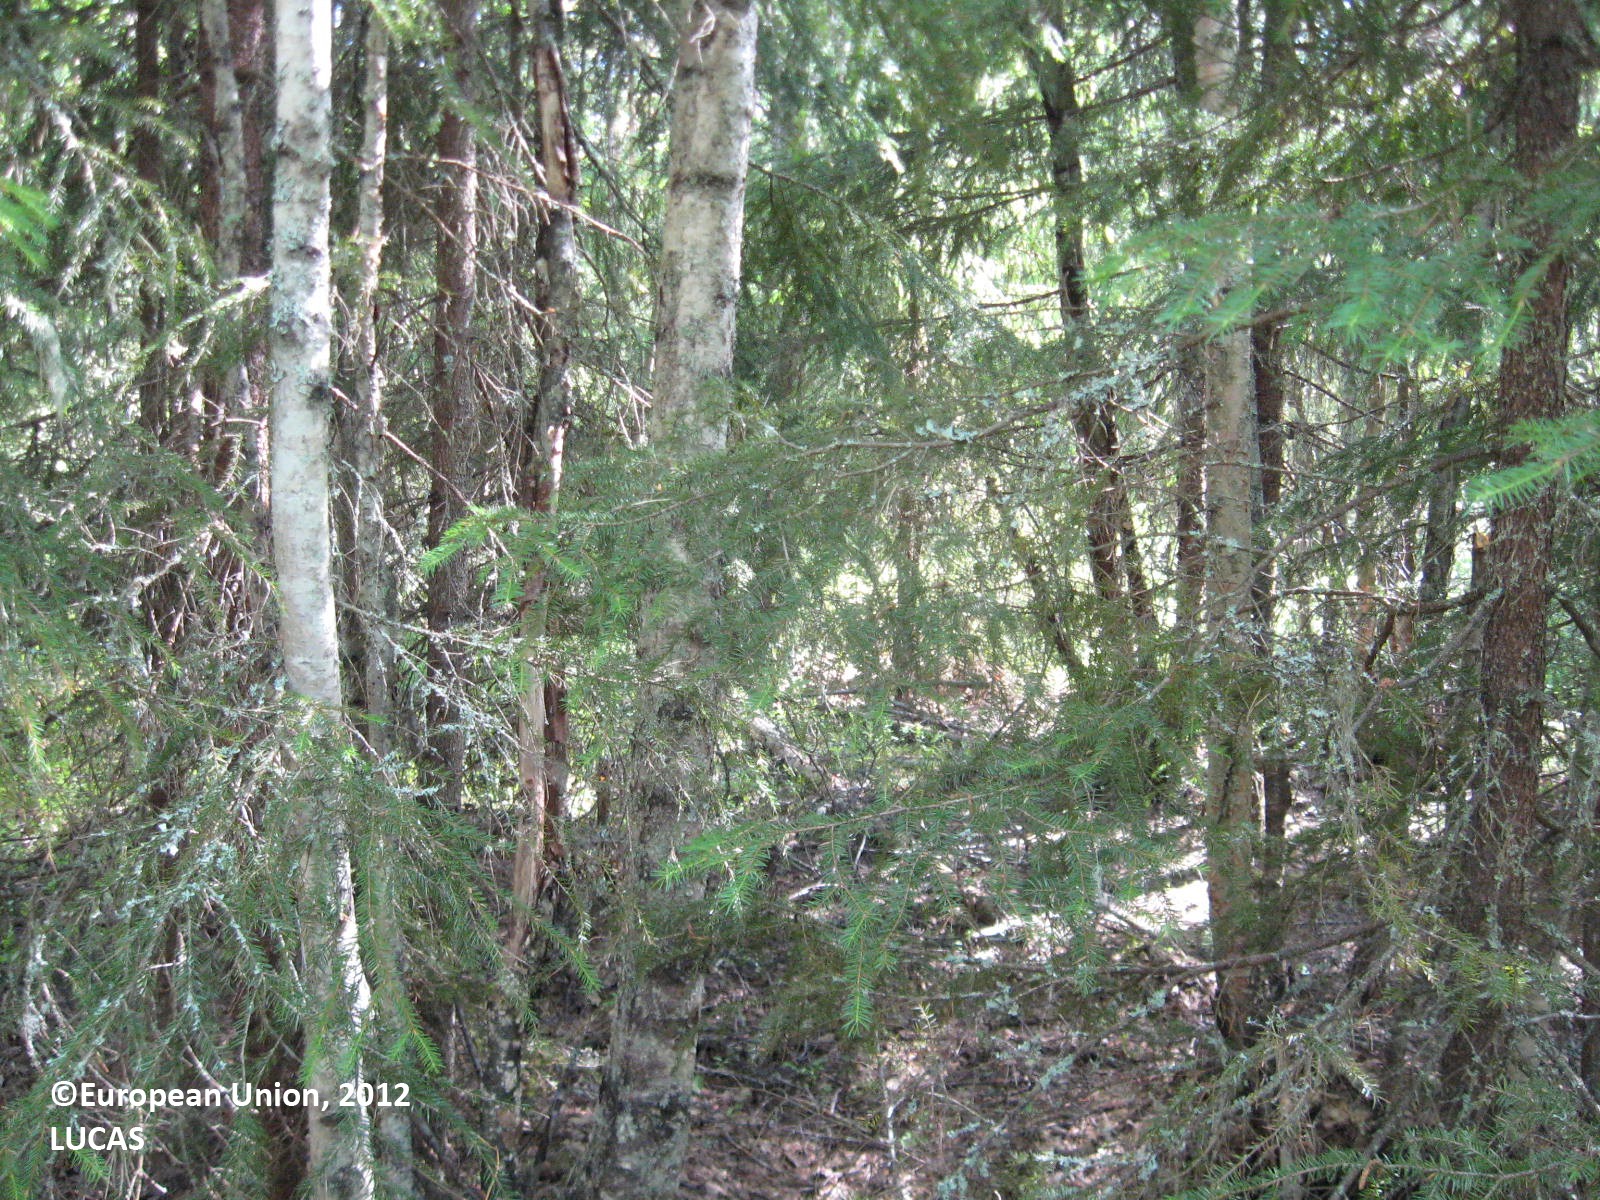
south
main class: Woodland
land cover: Other mixed woodland
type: boreal forest
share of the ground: > 75 %
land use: Forestry
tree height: > 5 m
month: June
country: FI
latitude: 62.6779
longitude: 21.7821
